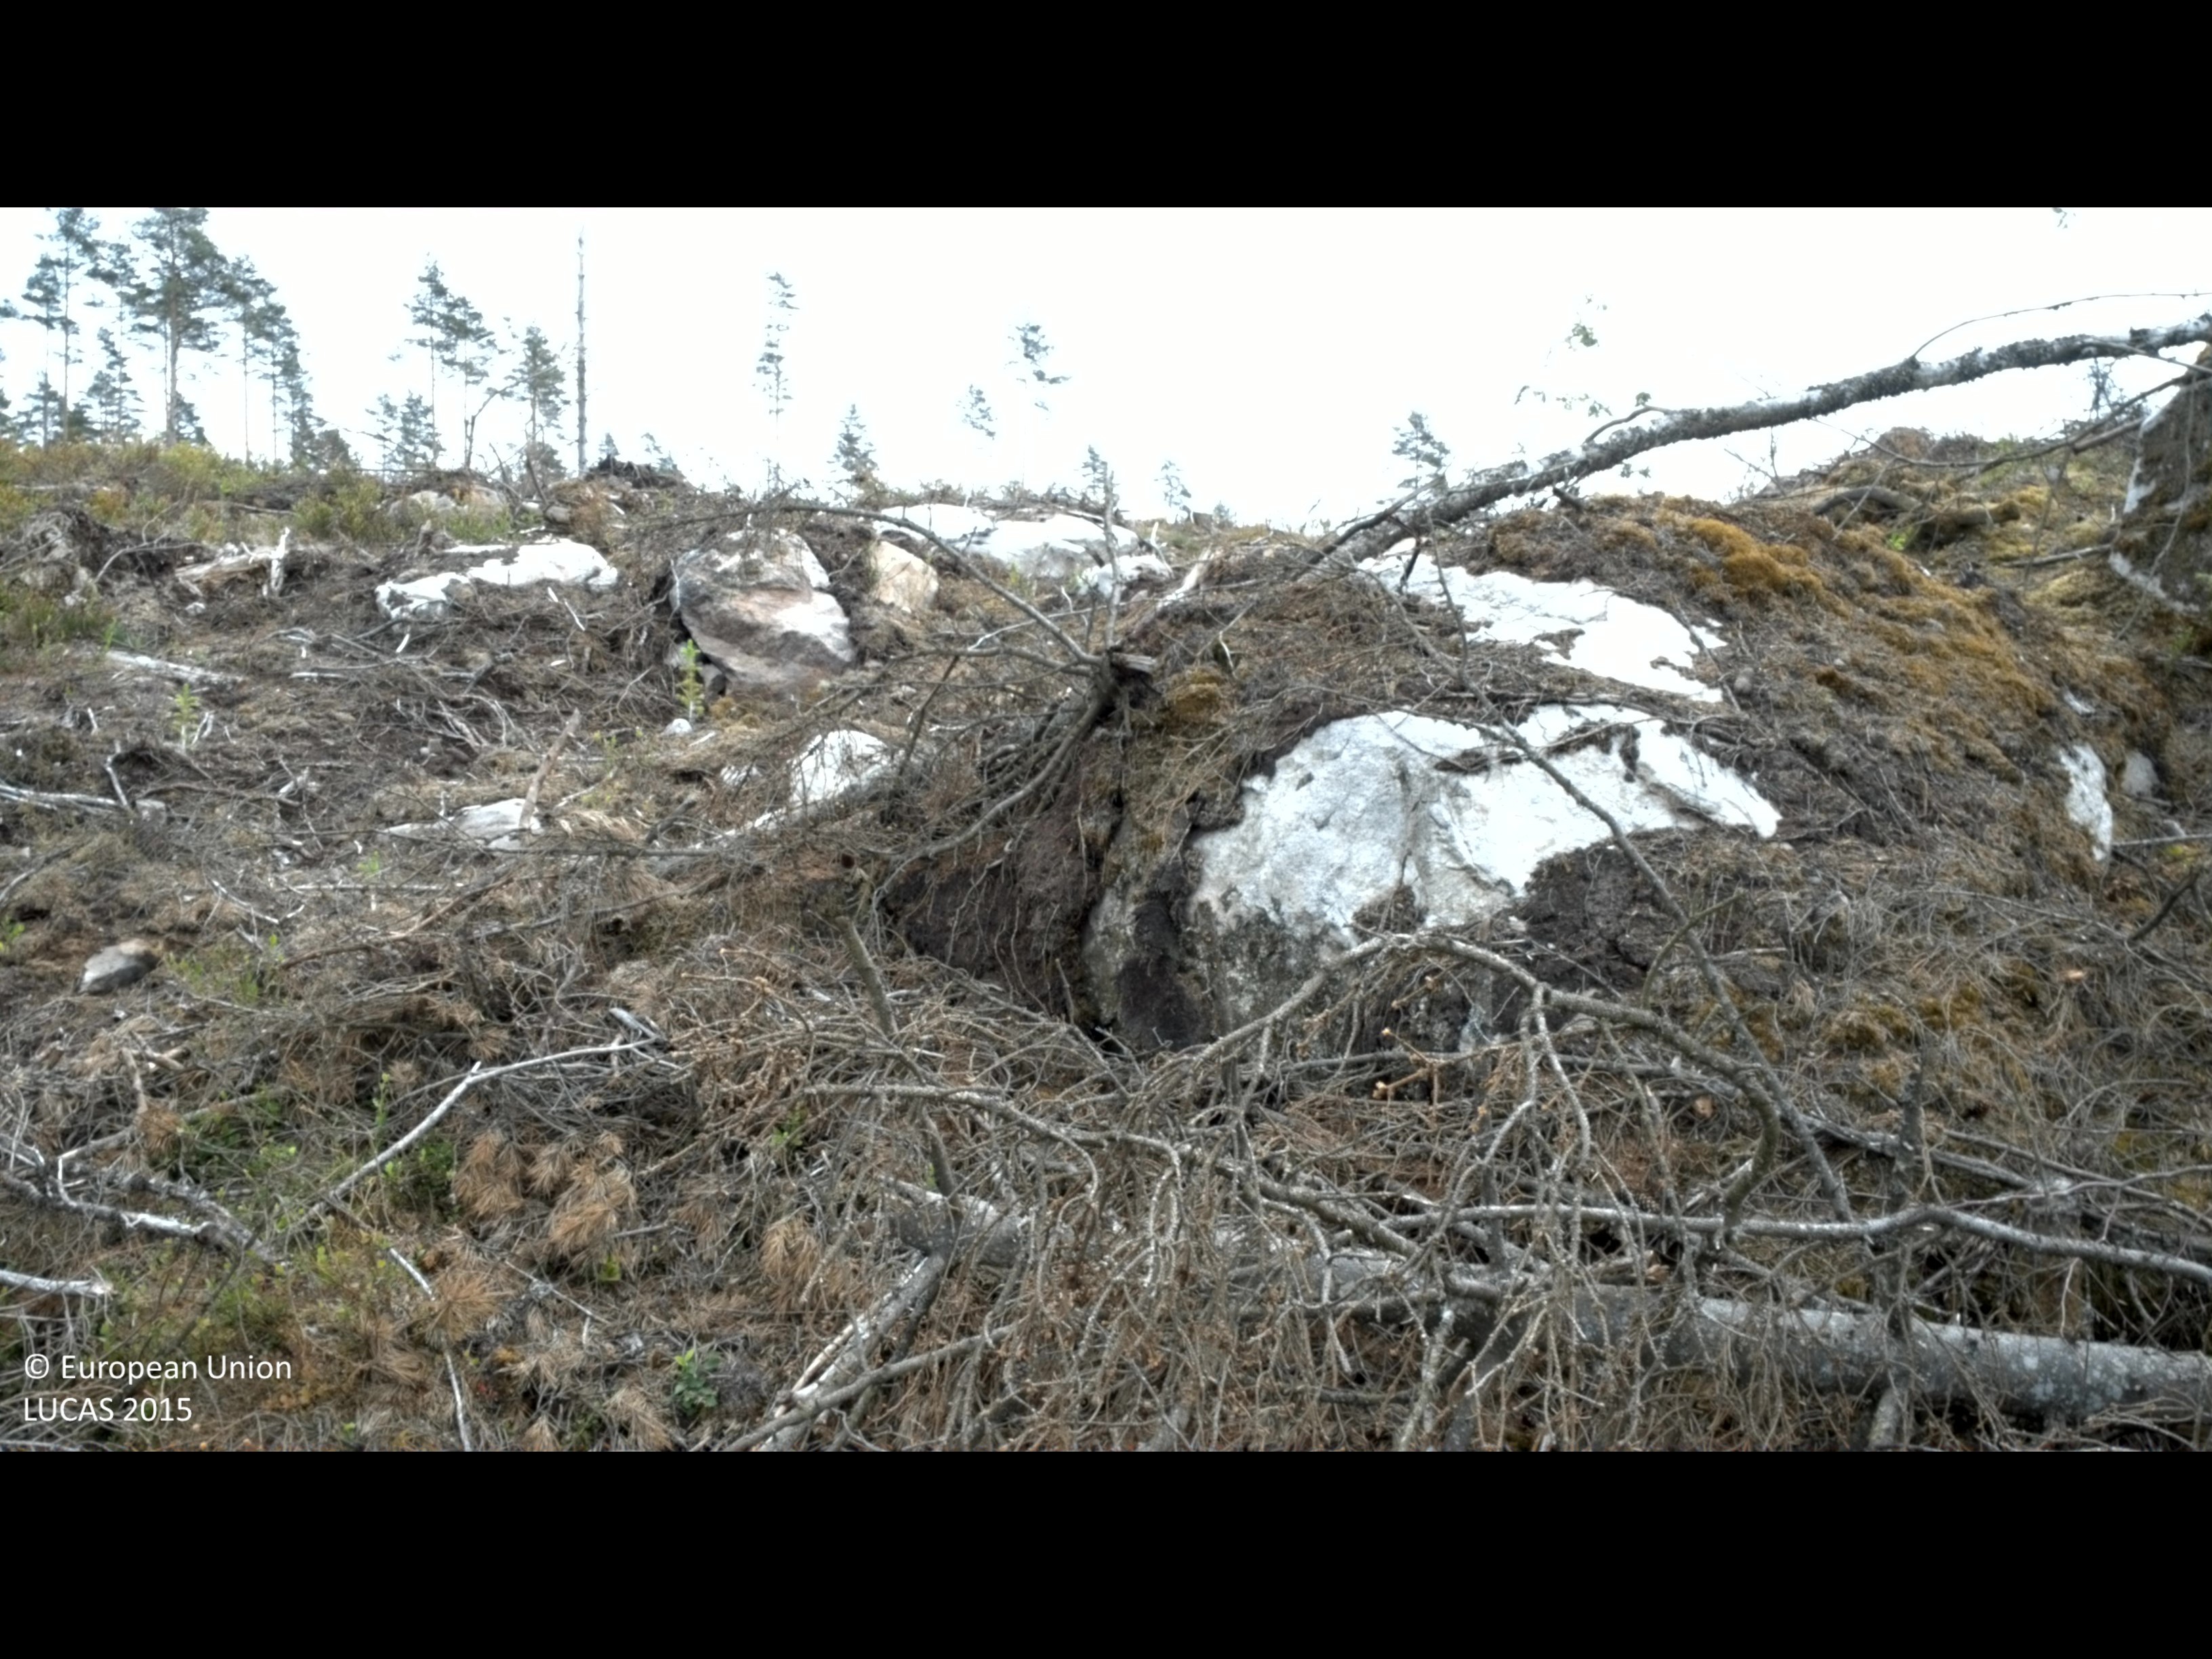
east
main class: Shrubland
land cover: Shrubland without tree cover
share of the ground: 10 - 25 %
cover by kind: unconsolidated bare surface 70 %, shrubs 20 %, consolidated bare surface 10 %
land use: Forestry
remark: Clear cut
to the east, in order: Shrubland without tree cover; Other bare soil; Shrubland with sparse tree cover; Pine dominated coniferous woodland
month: July
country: SE
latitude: 56.4704
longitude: 14.4615
